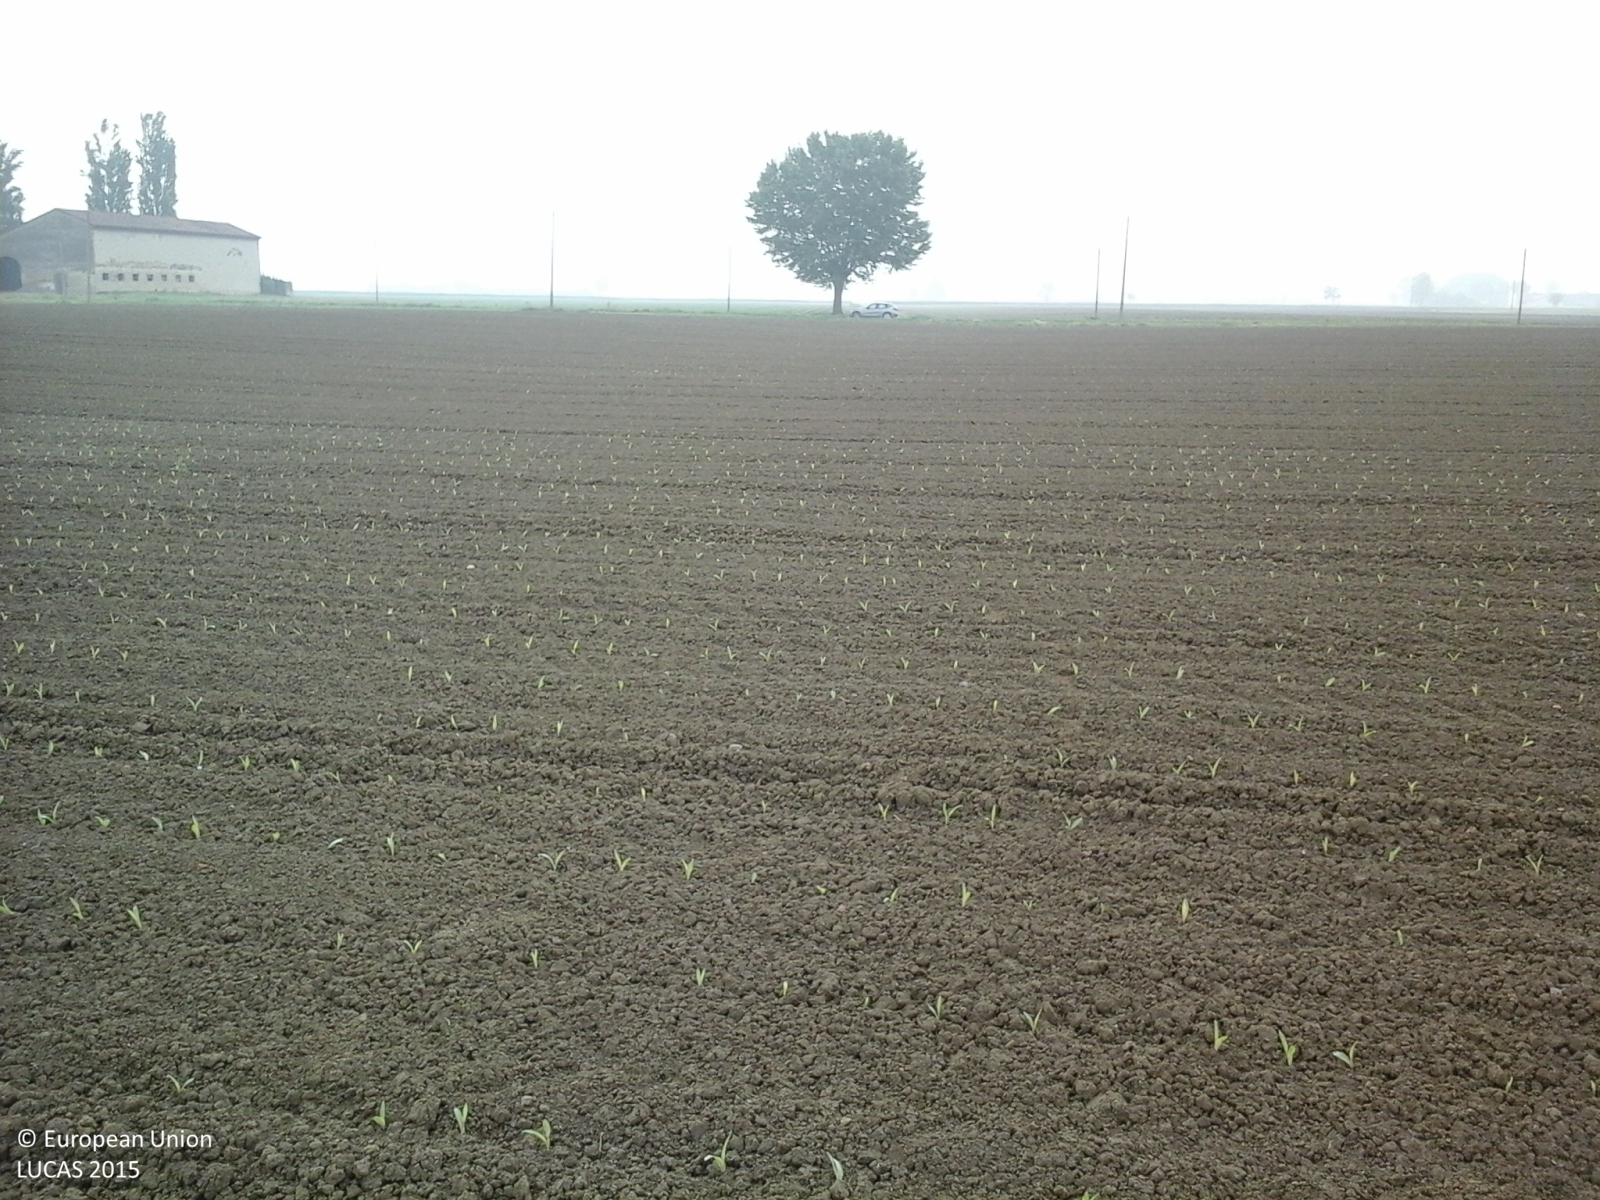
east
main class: Cropland
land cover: Maize
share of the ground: < 10 %
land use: Agriculture (excluding fallow land and kitchen gardens)
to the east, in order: Maize; Electric lines; Ditches and canals; Paved roads, cycling and walking lanes; Grass margins; Electric lines; Ditches and canals; Single bushes/trees; Tomatoes
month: May
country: IT
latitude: 45.0530
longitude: 10.4182
